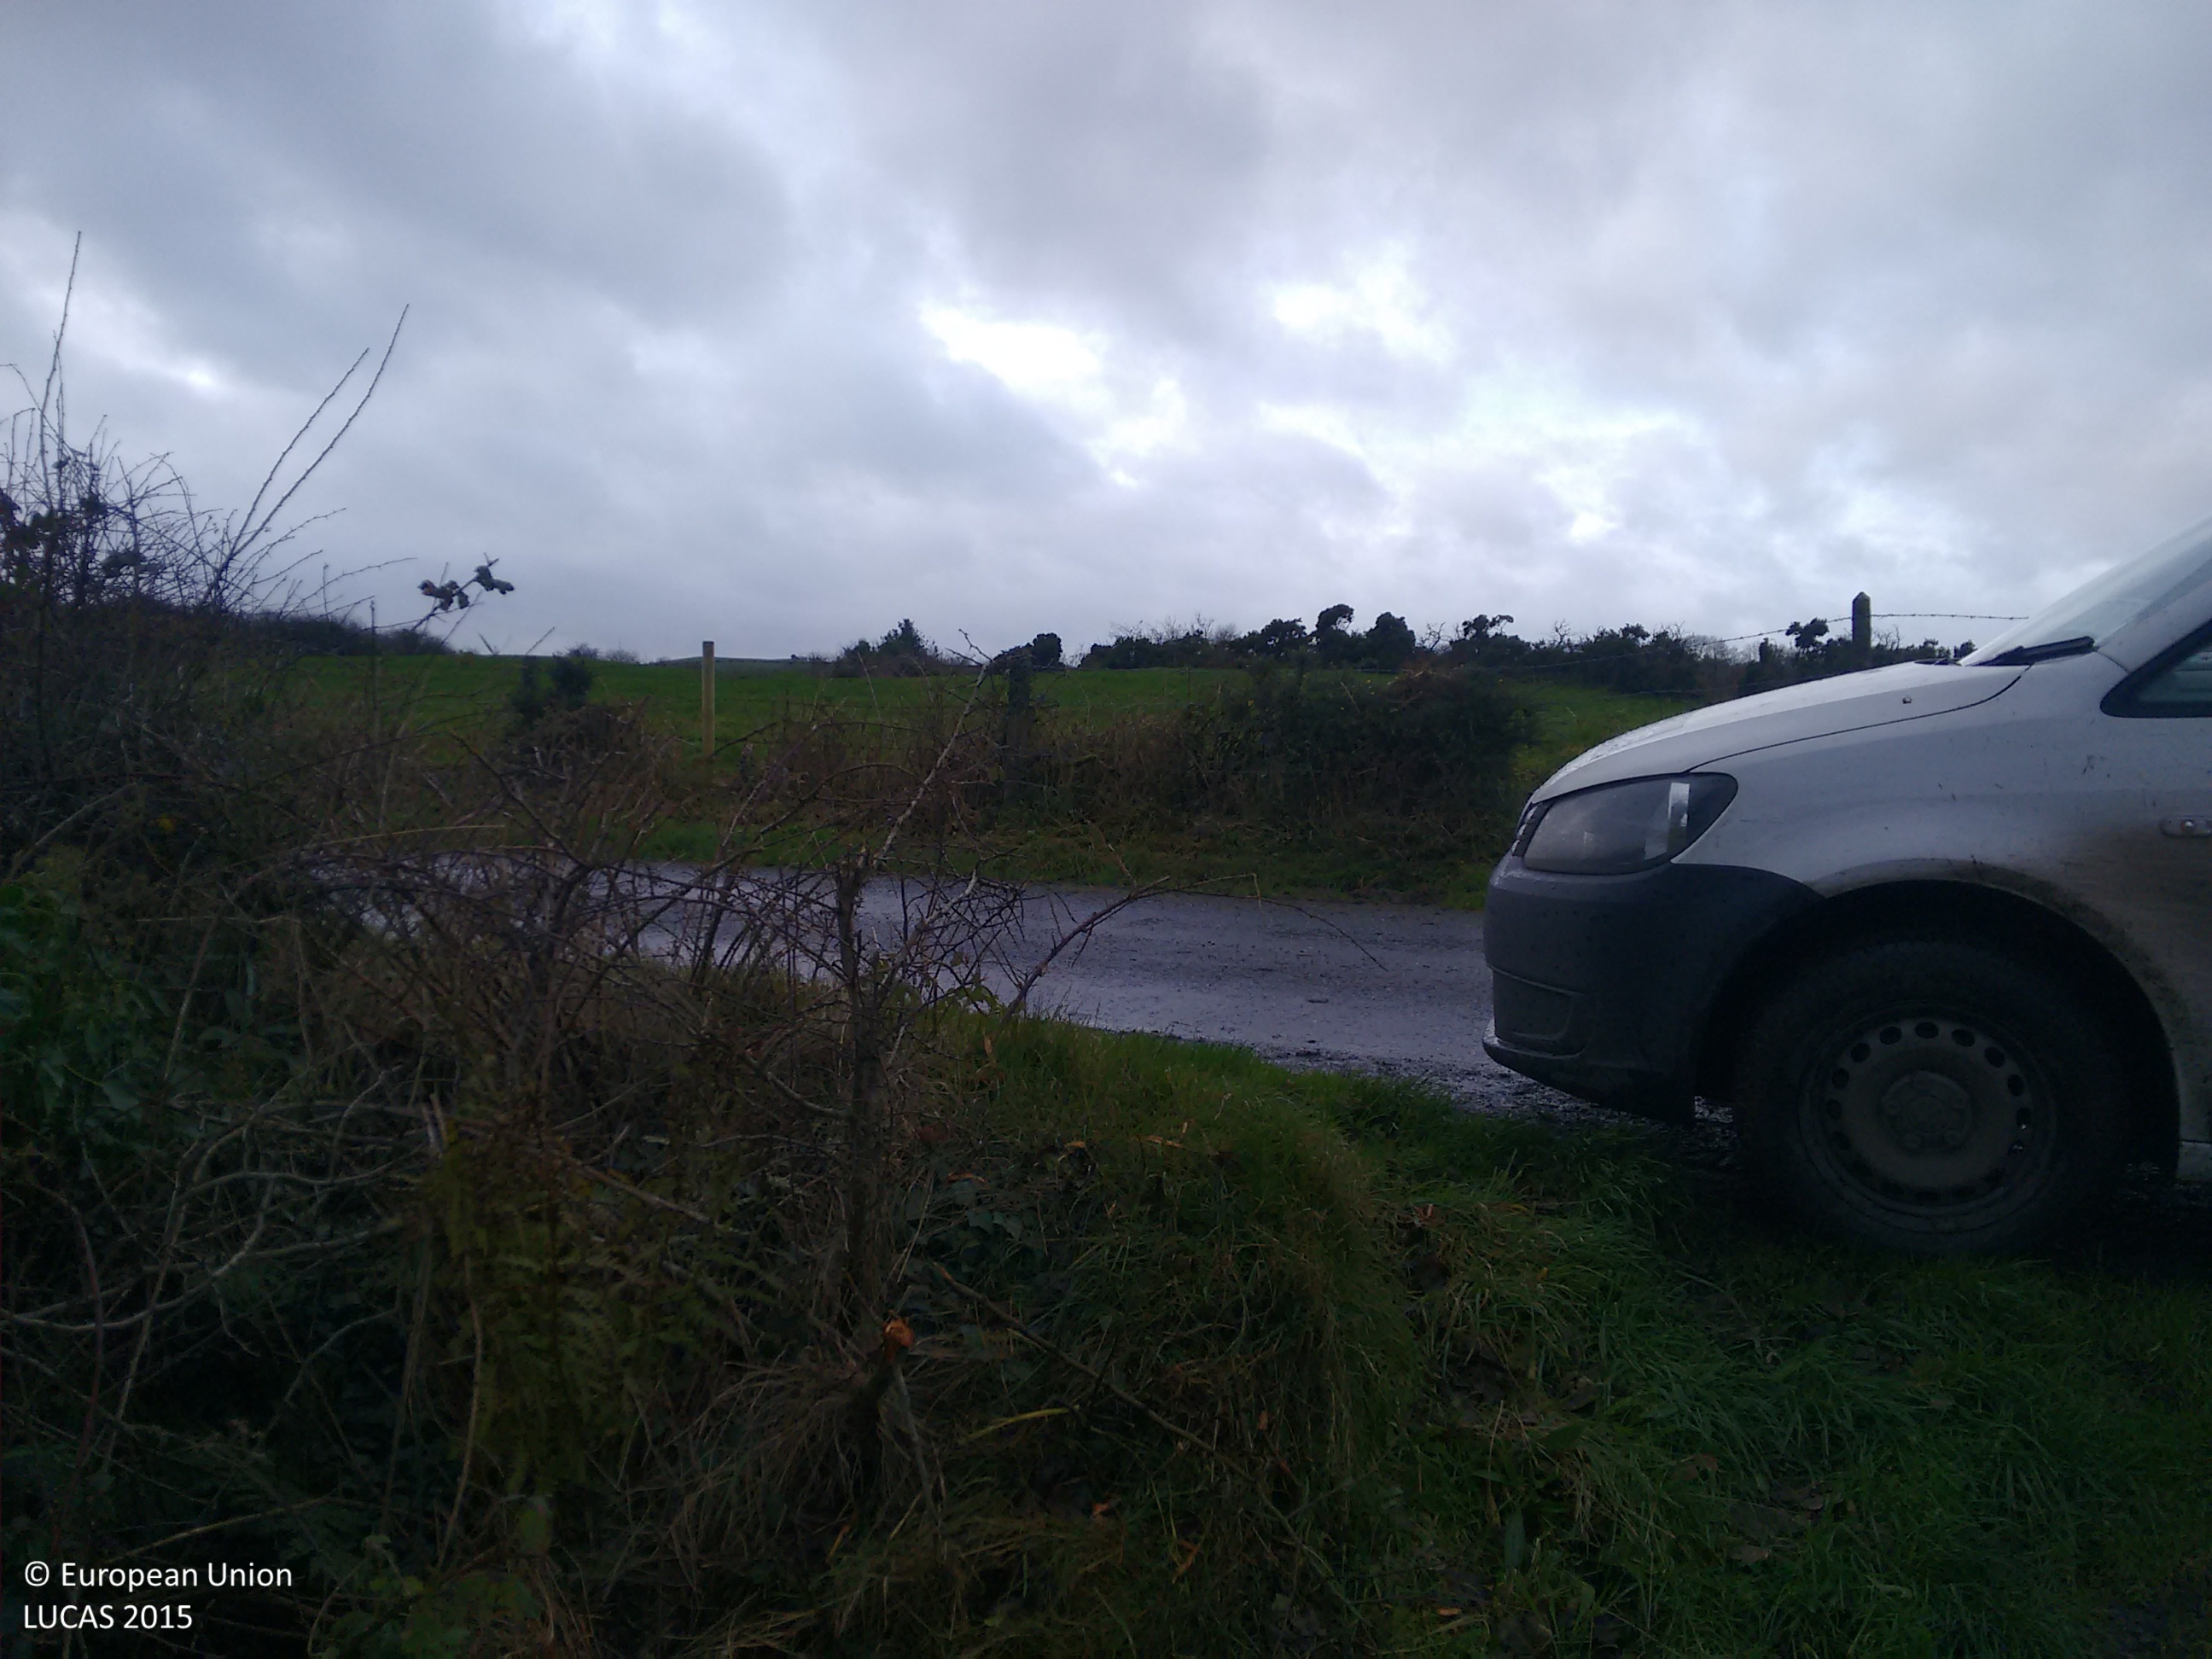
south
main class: Grassland
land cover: Grassland without tree/shrub cover
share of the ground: > 75 %
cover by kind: herbaceous plants 100 %
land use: Agriculture (excluding fallow land and kitchen gardens)
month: December
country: IE
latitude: 54.0825
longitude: -7.0010
